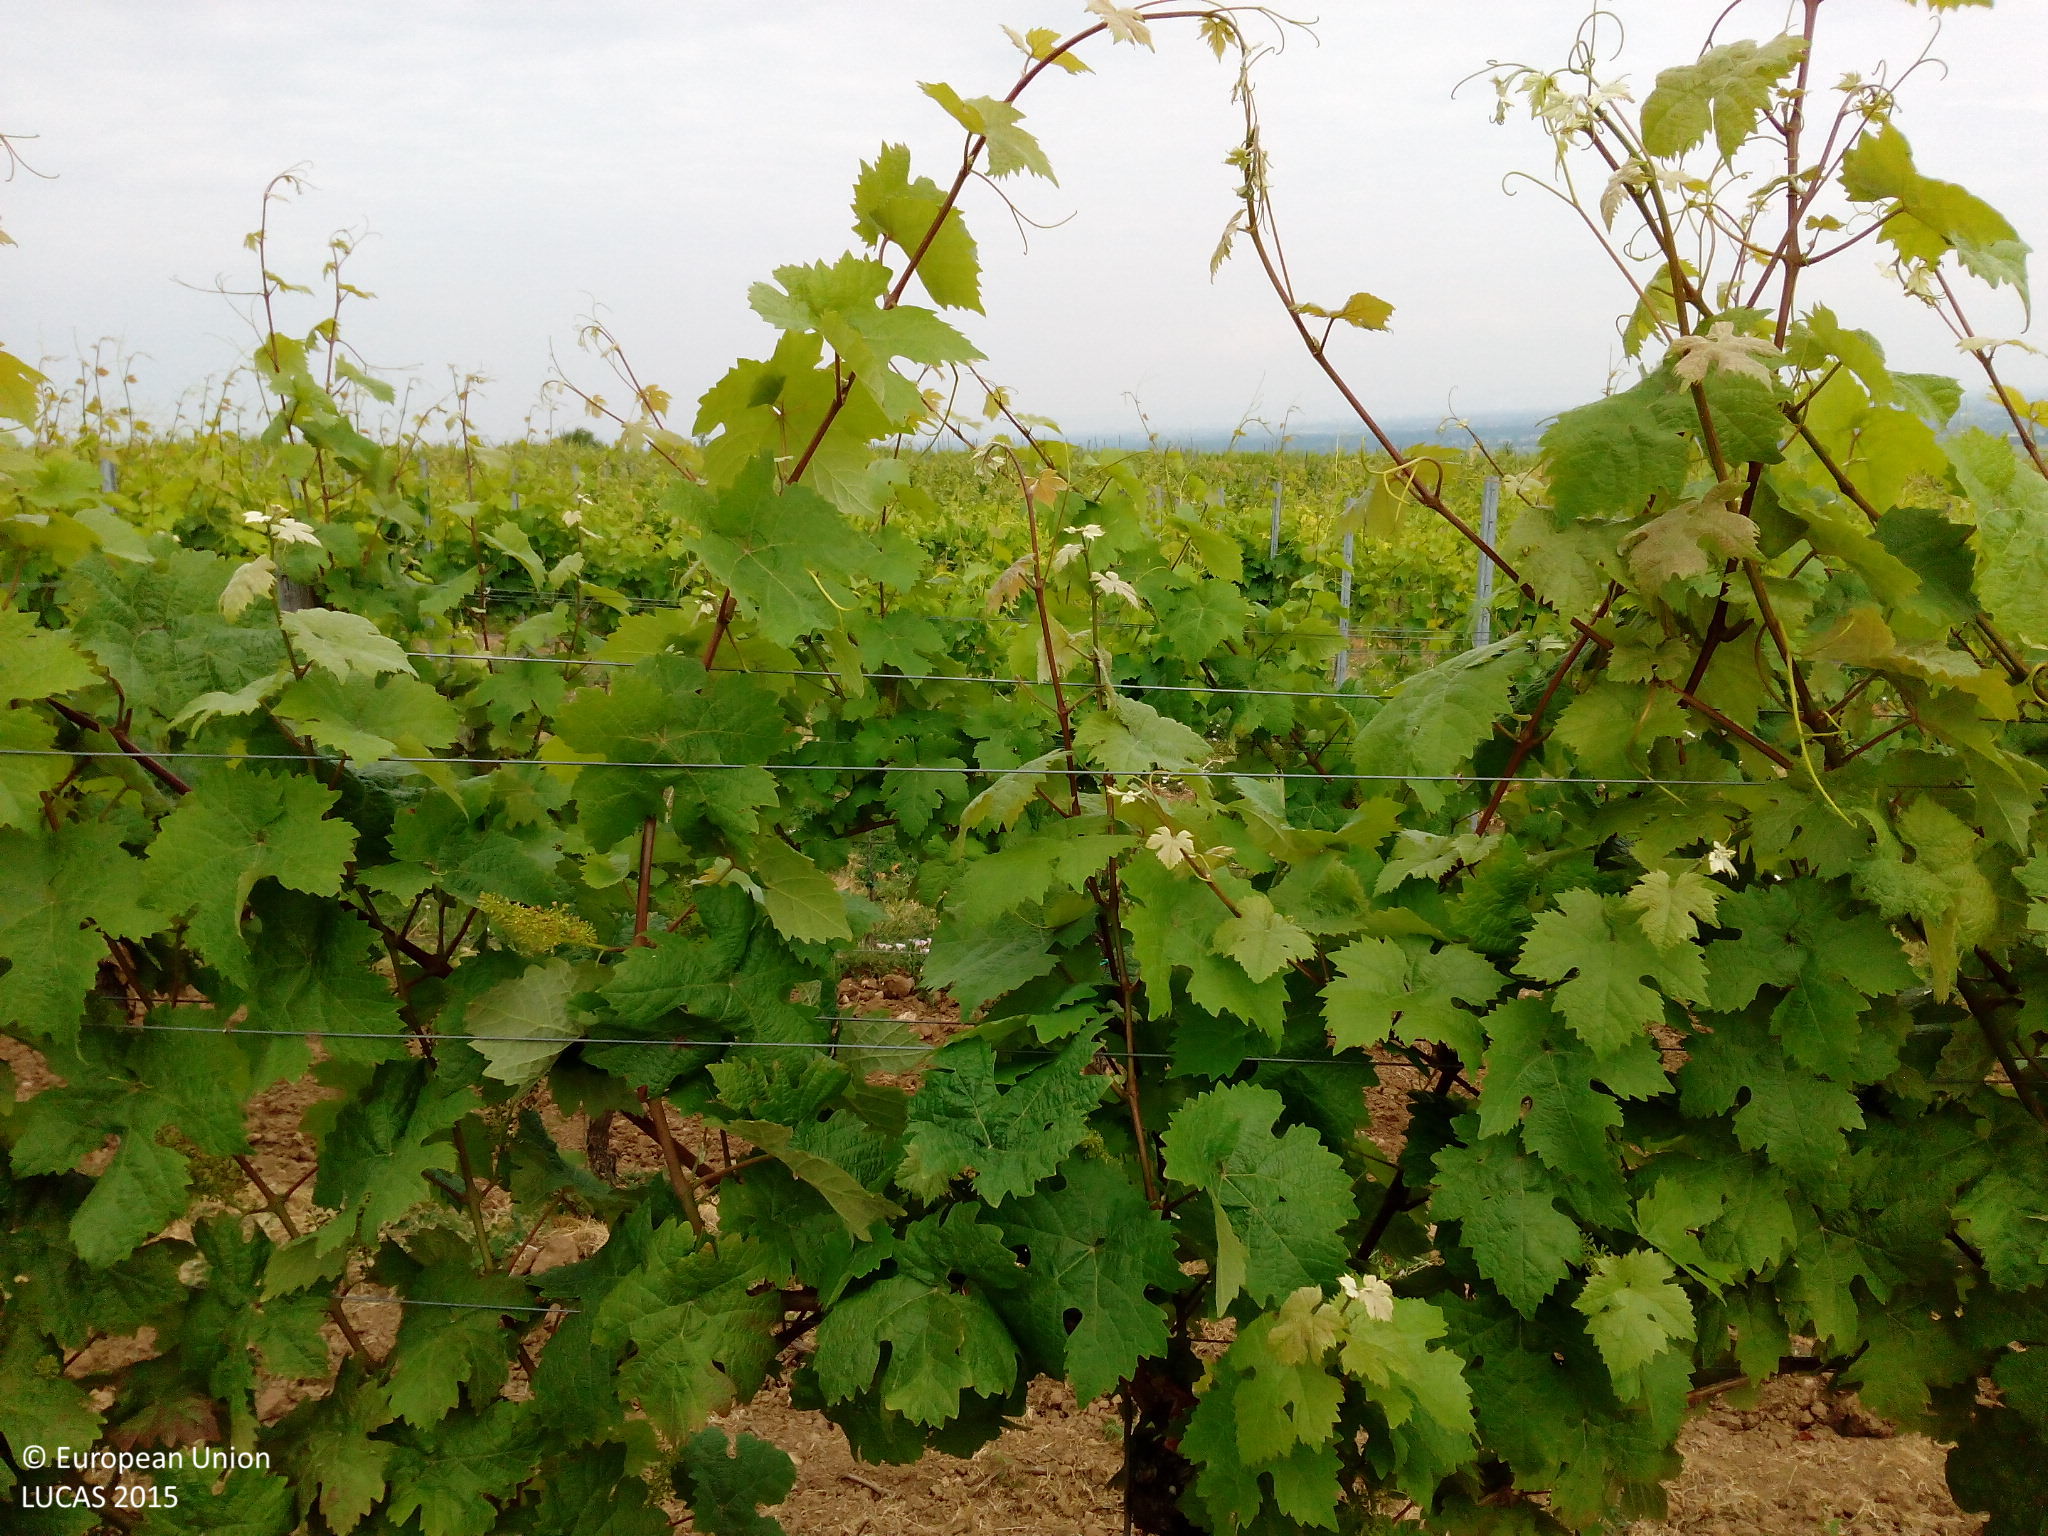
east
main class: Cropland
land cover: Vineyards
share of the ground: 10 - 25 %
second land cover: Spontaneously vegetated surfaces
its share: 25 - 50 %
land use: Agriculture (excluding fallow land and kitchen gardens)
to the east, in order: Vineyards; Spontaneously vegetated surfaces; Tracks; Vineyards; Spontaneously vegetated surfaces; Tracks; Grass margins; Vineyards
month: June
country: DE
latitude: 49.5039
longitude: 8.1639
